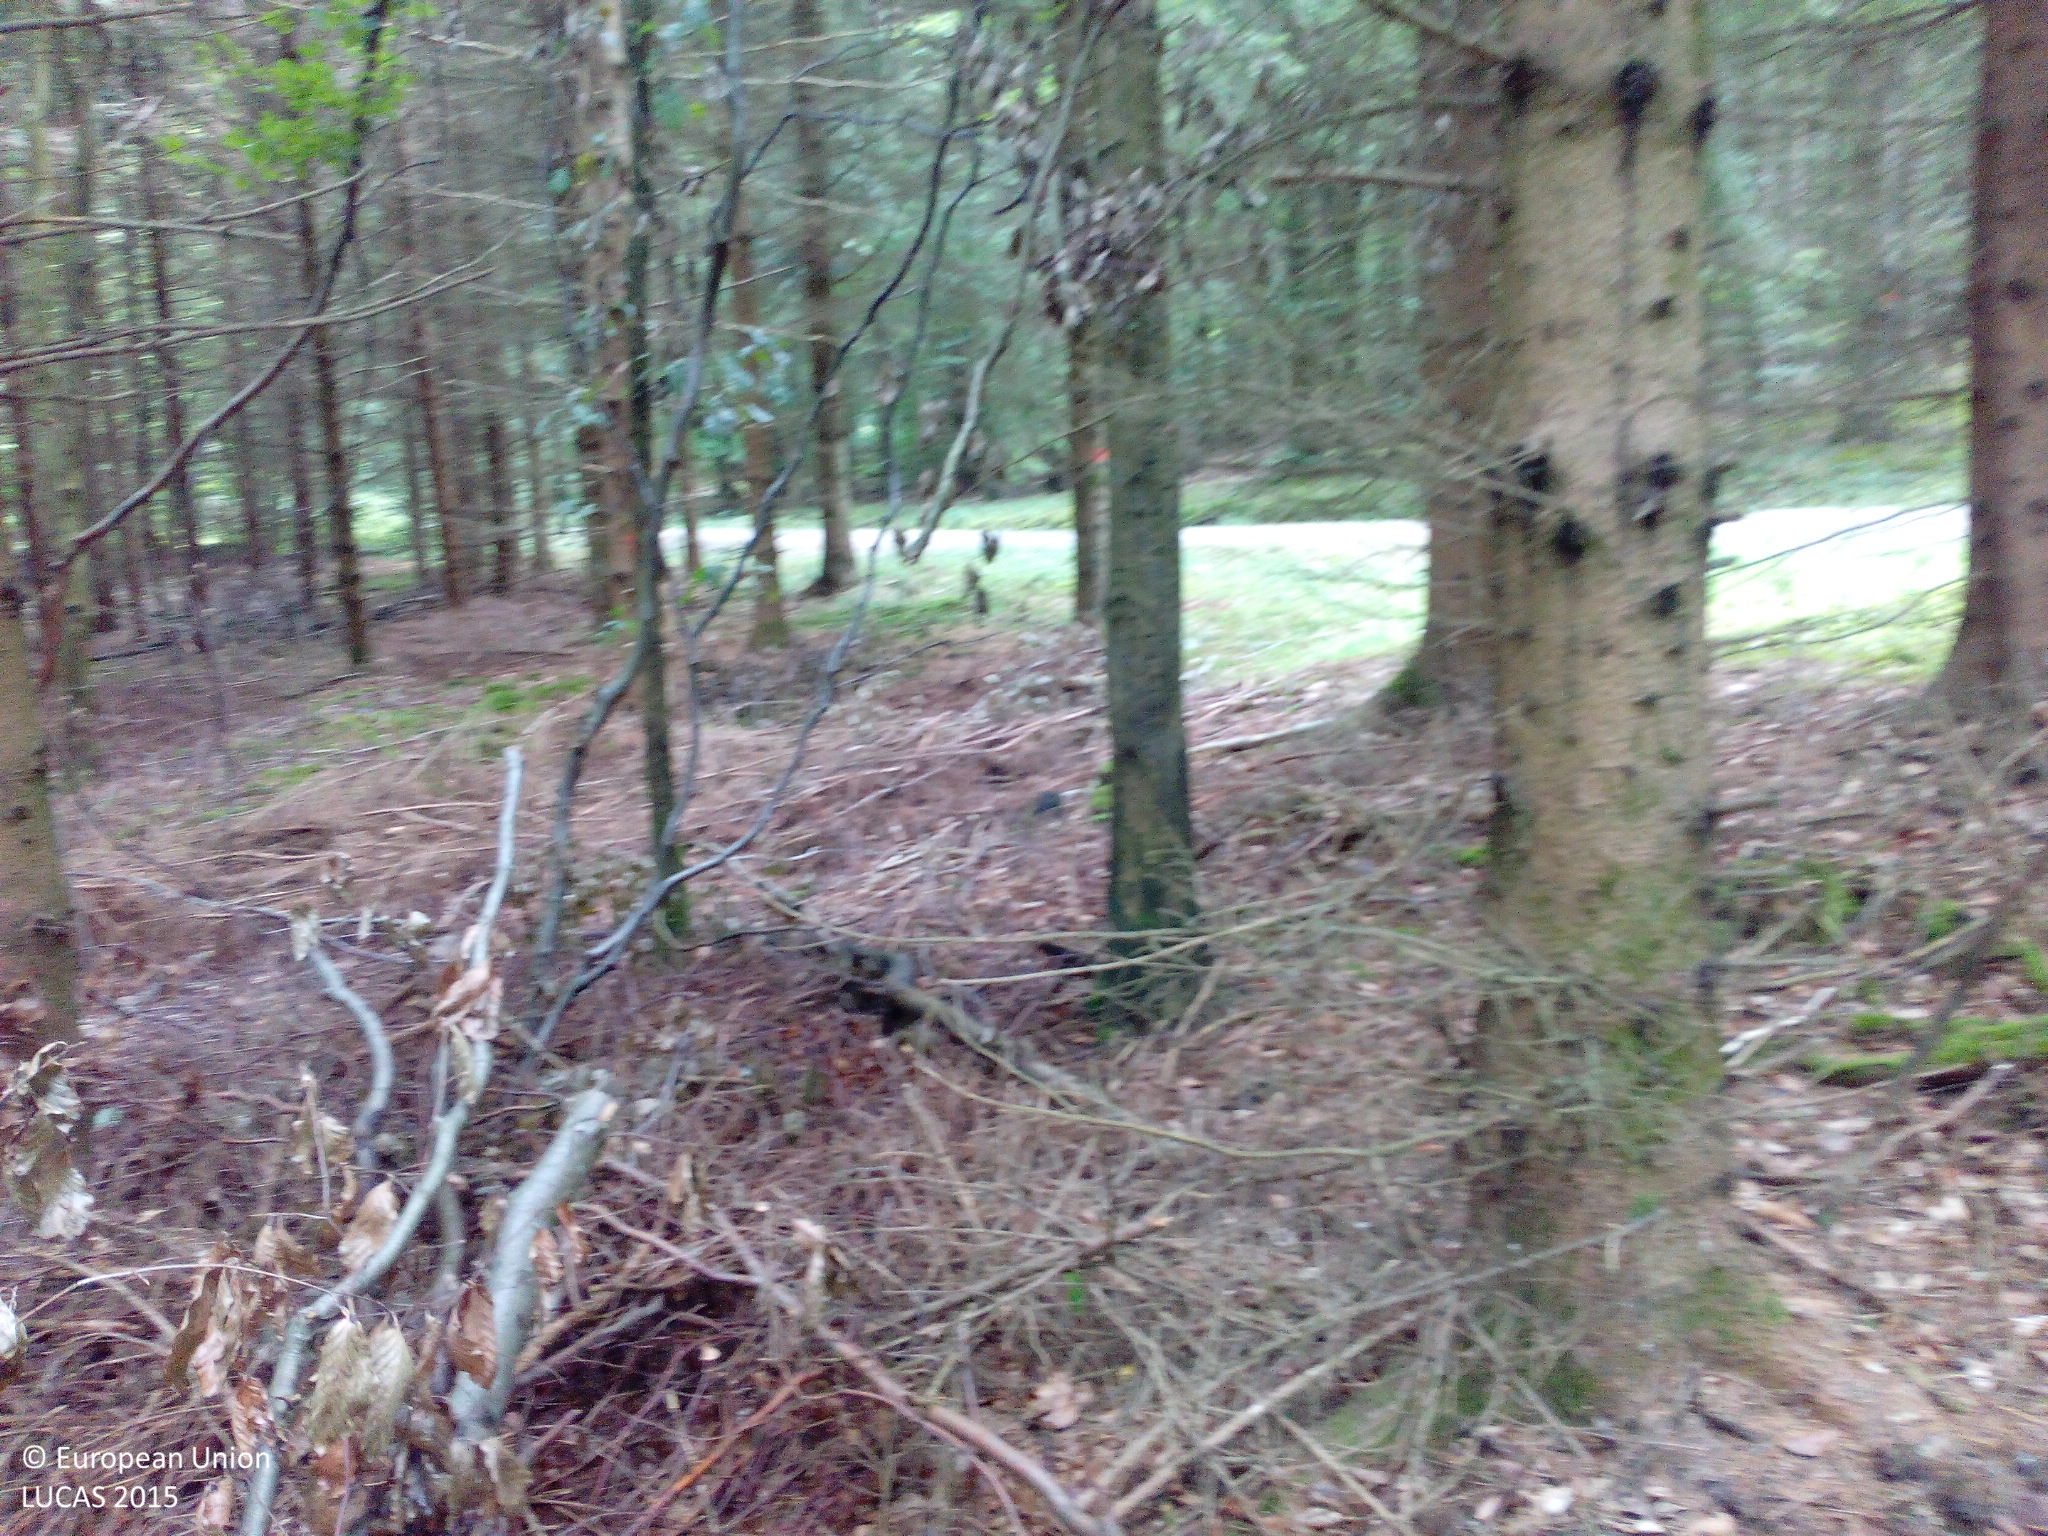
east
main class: Woodland
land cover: Spruce dominated mixed woodland
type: hemiboreal forest and nemoral coniferous forest and mixed broadleaved-coniferous forest
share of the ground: > 75 %
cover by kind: coniferous forest trees 50 %, broadleaved forest trees 25 %, unconsolidated bare surface 15 %, lichens and mosses 10 %
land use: Forestry
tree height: > 5 m
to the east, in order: Spruce dominated mixed woodland; Tracks; Spruce dominated coniferous woodland; Broadleaved woodland; Spruce dominated mixed woodland; Broadleaved woodland
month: August
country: DE
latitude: 50.2750
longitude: 8.0219
